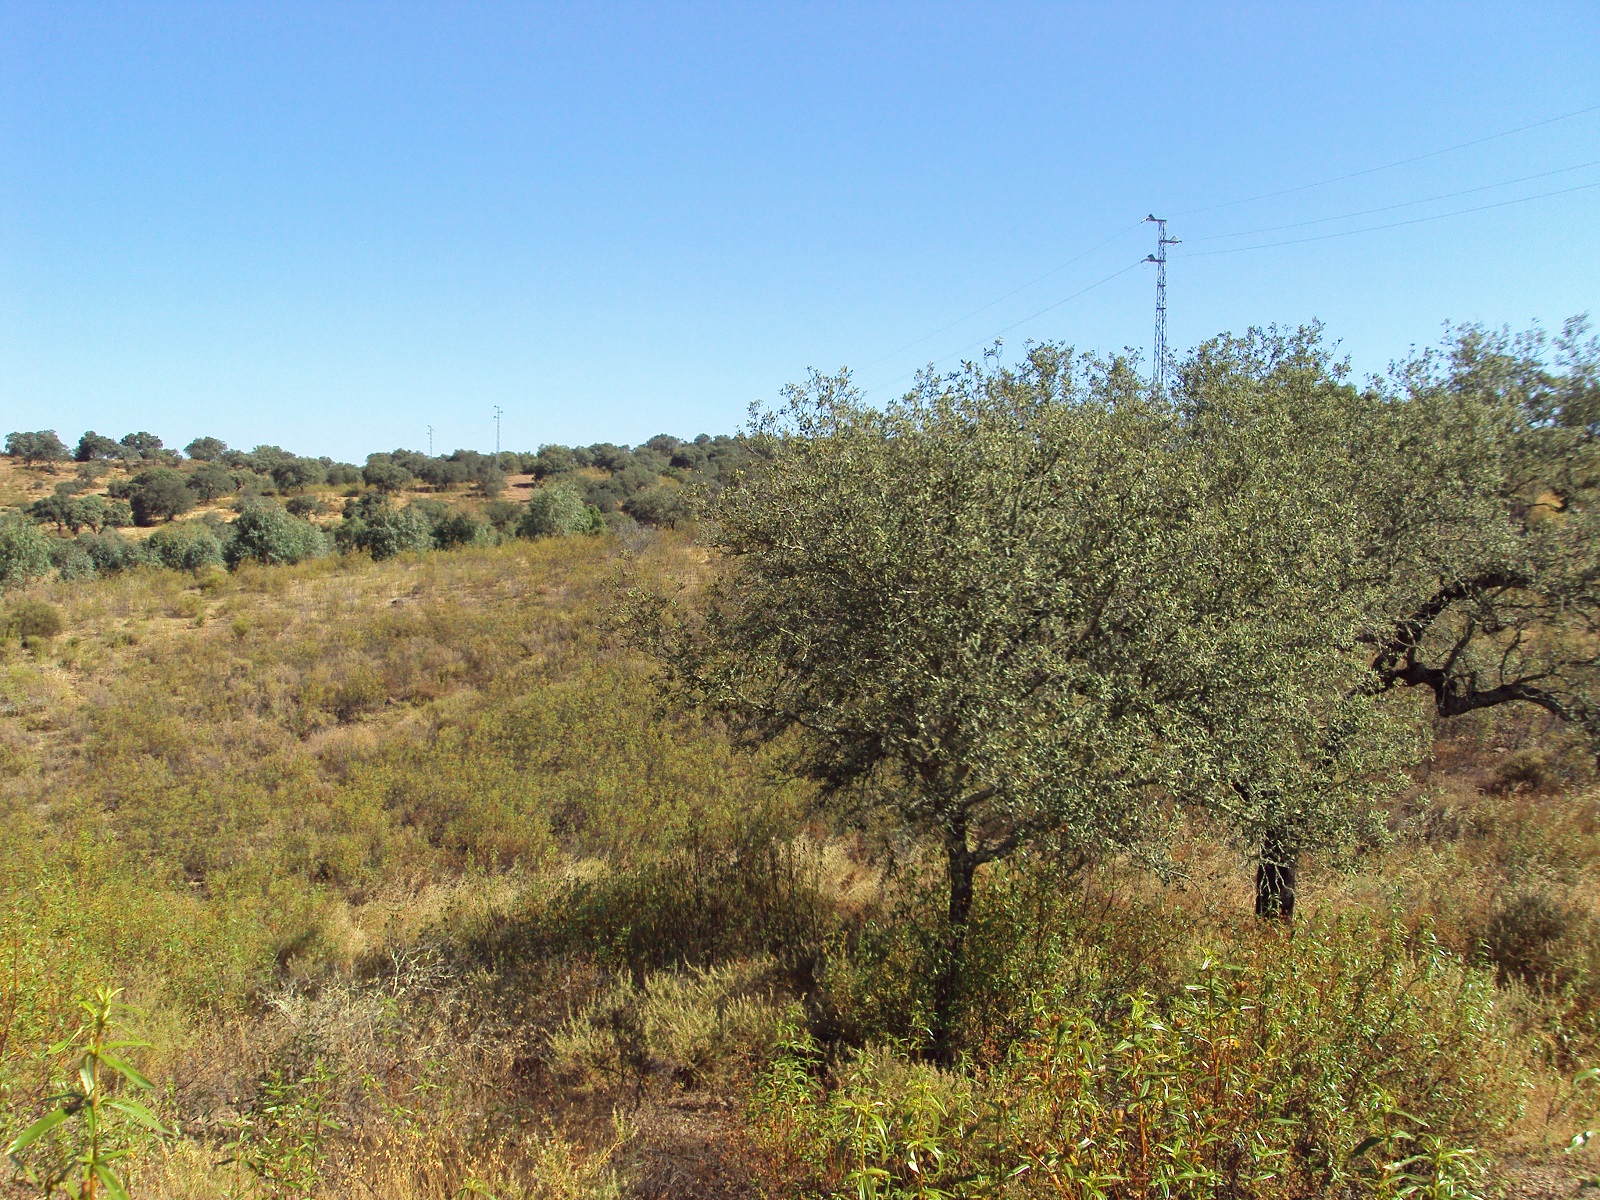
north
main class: Woodland
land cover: Broadleaved woodland
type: broadleaved evergreen forest
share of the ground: 50 - 75 %
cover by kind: broadleaved forest trees 50 %, shrubs 40 %, herbaceous plants 10 %
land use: Agriculture (excluding fallow land and kitchen gardens)
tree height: > 5 m
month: June
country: ES
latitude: 37.5309
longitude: -7.1234
